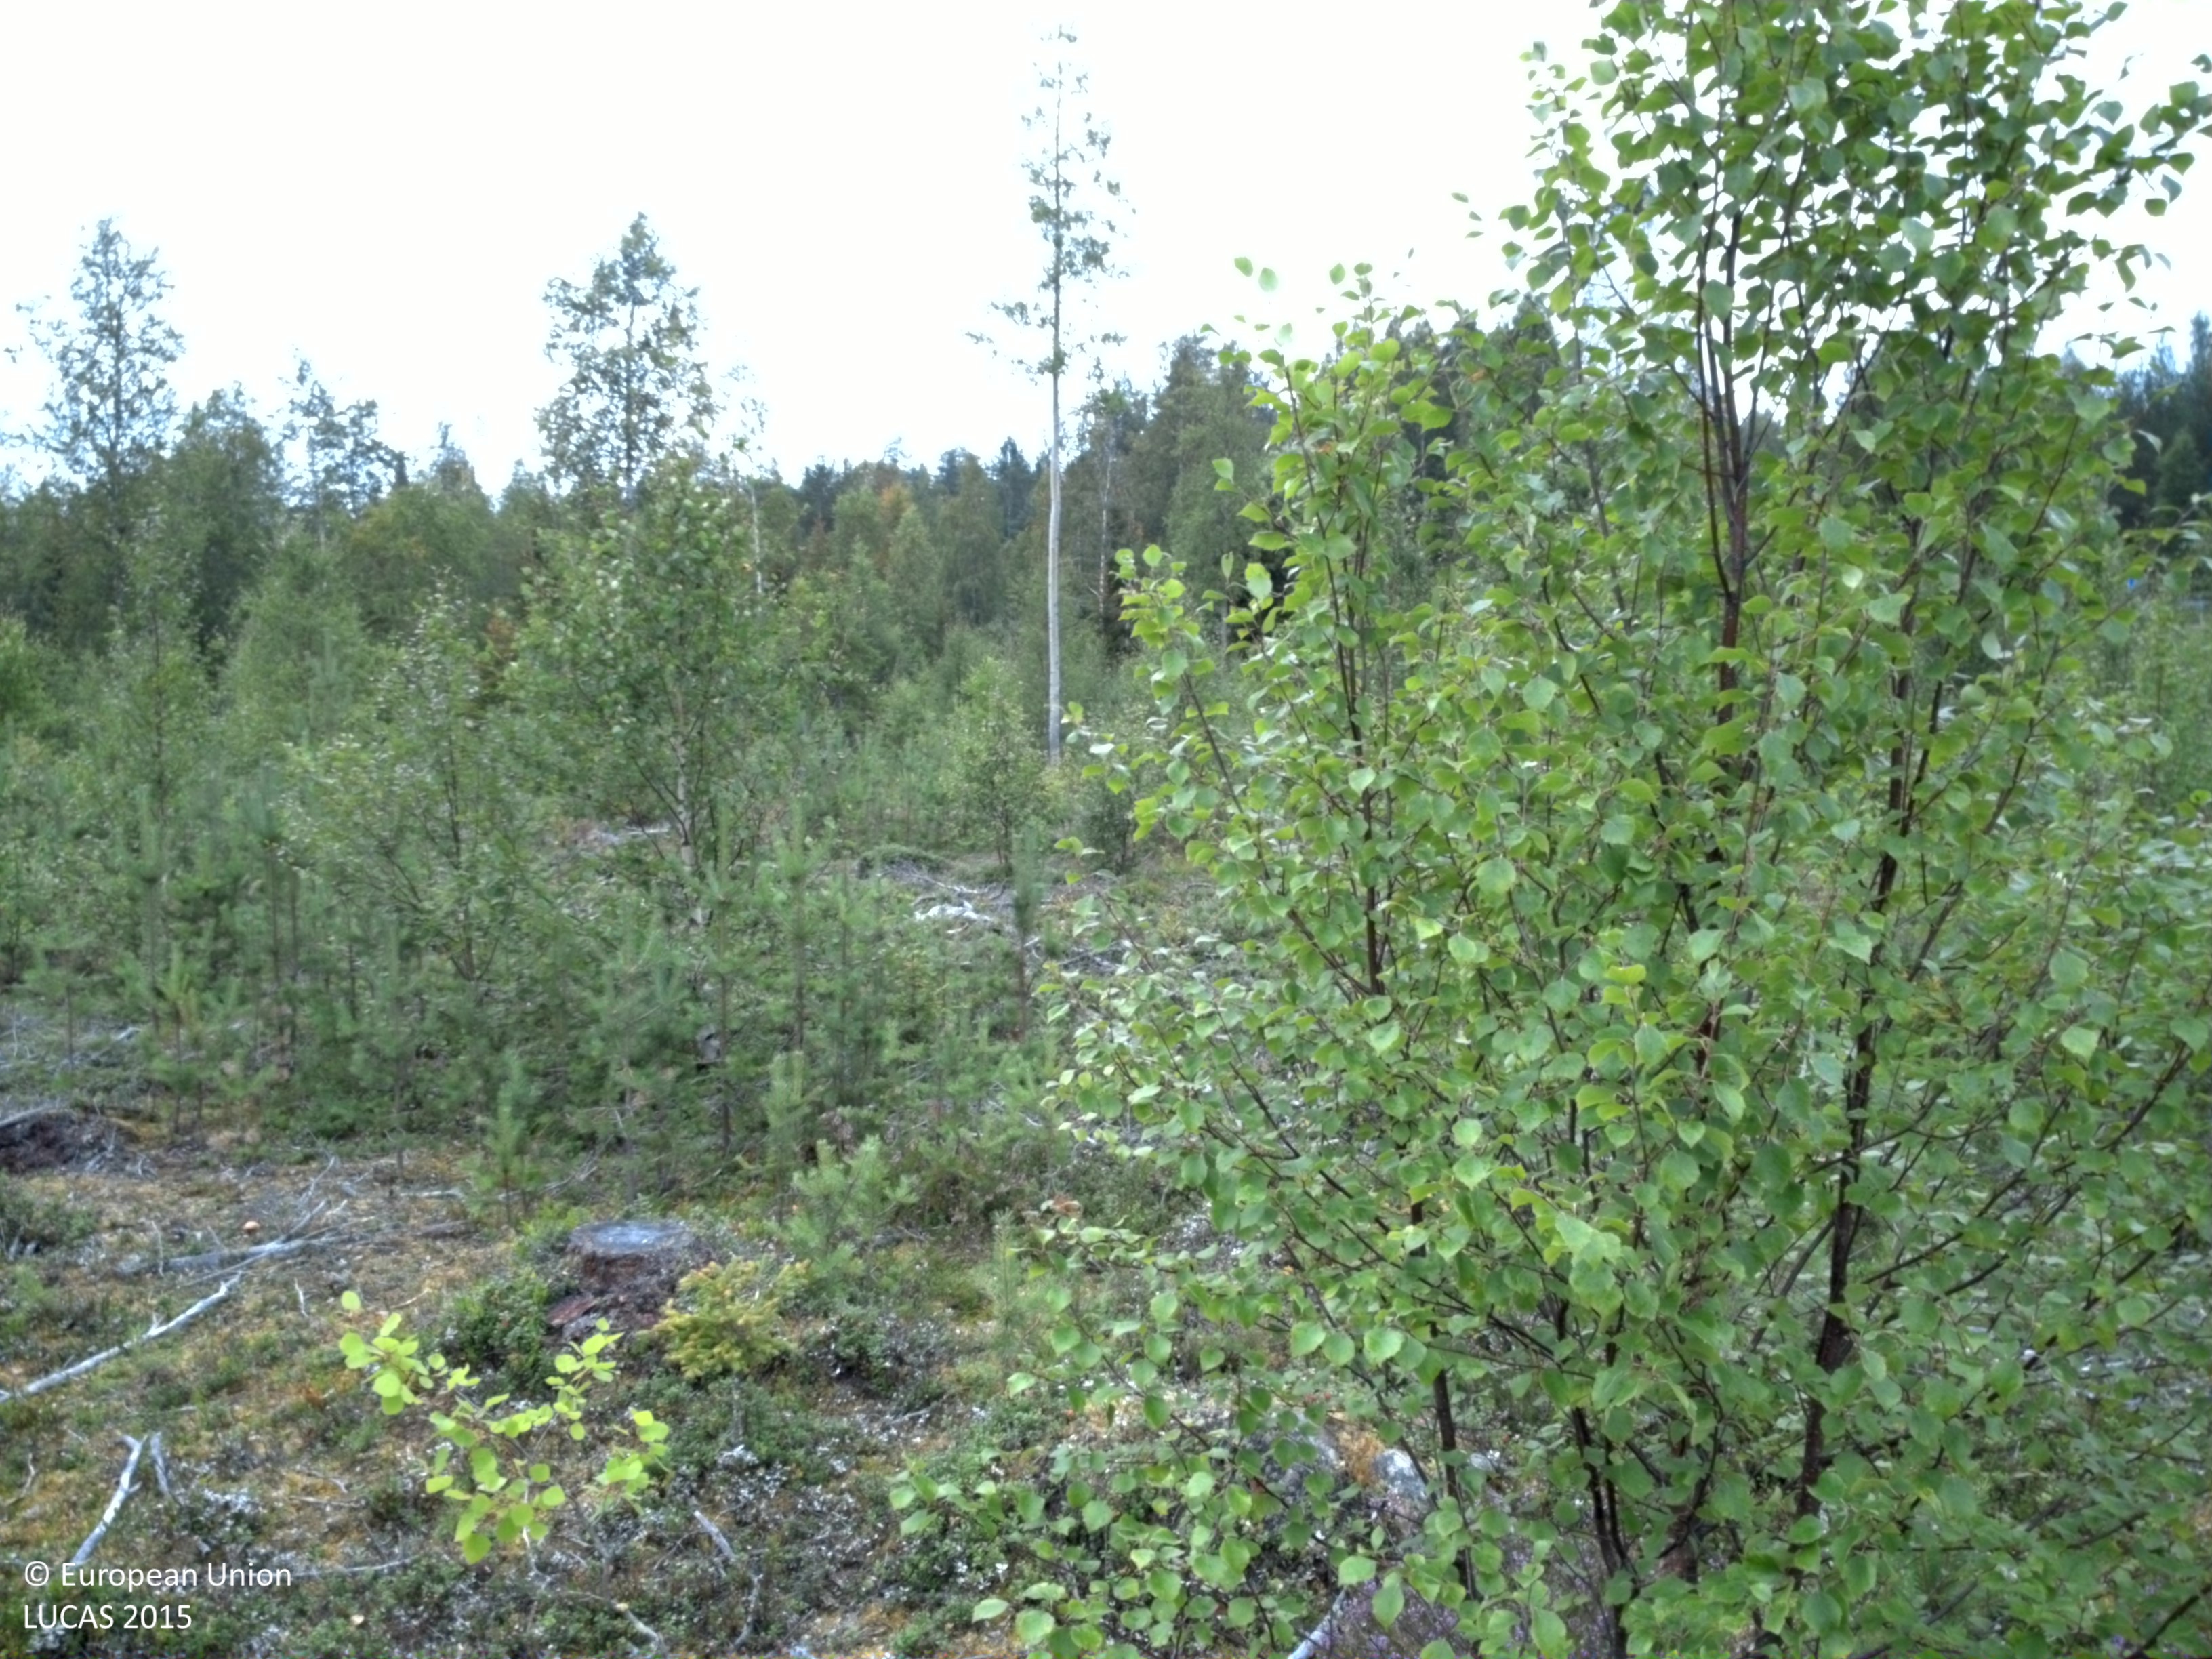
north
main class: Woodland
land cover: Pine dominated mixed woodland
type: boreal forest
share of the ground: 25 - 50 %
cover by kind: shrubs 60 %, broadleaved forest trees 20 %, coniferous forest trees 10 %, lichens and mosses 10 %
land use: Forestry
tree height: < 5 m
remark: Clear cut
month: August
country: SE
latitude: 65.9974
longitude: 22.6924
